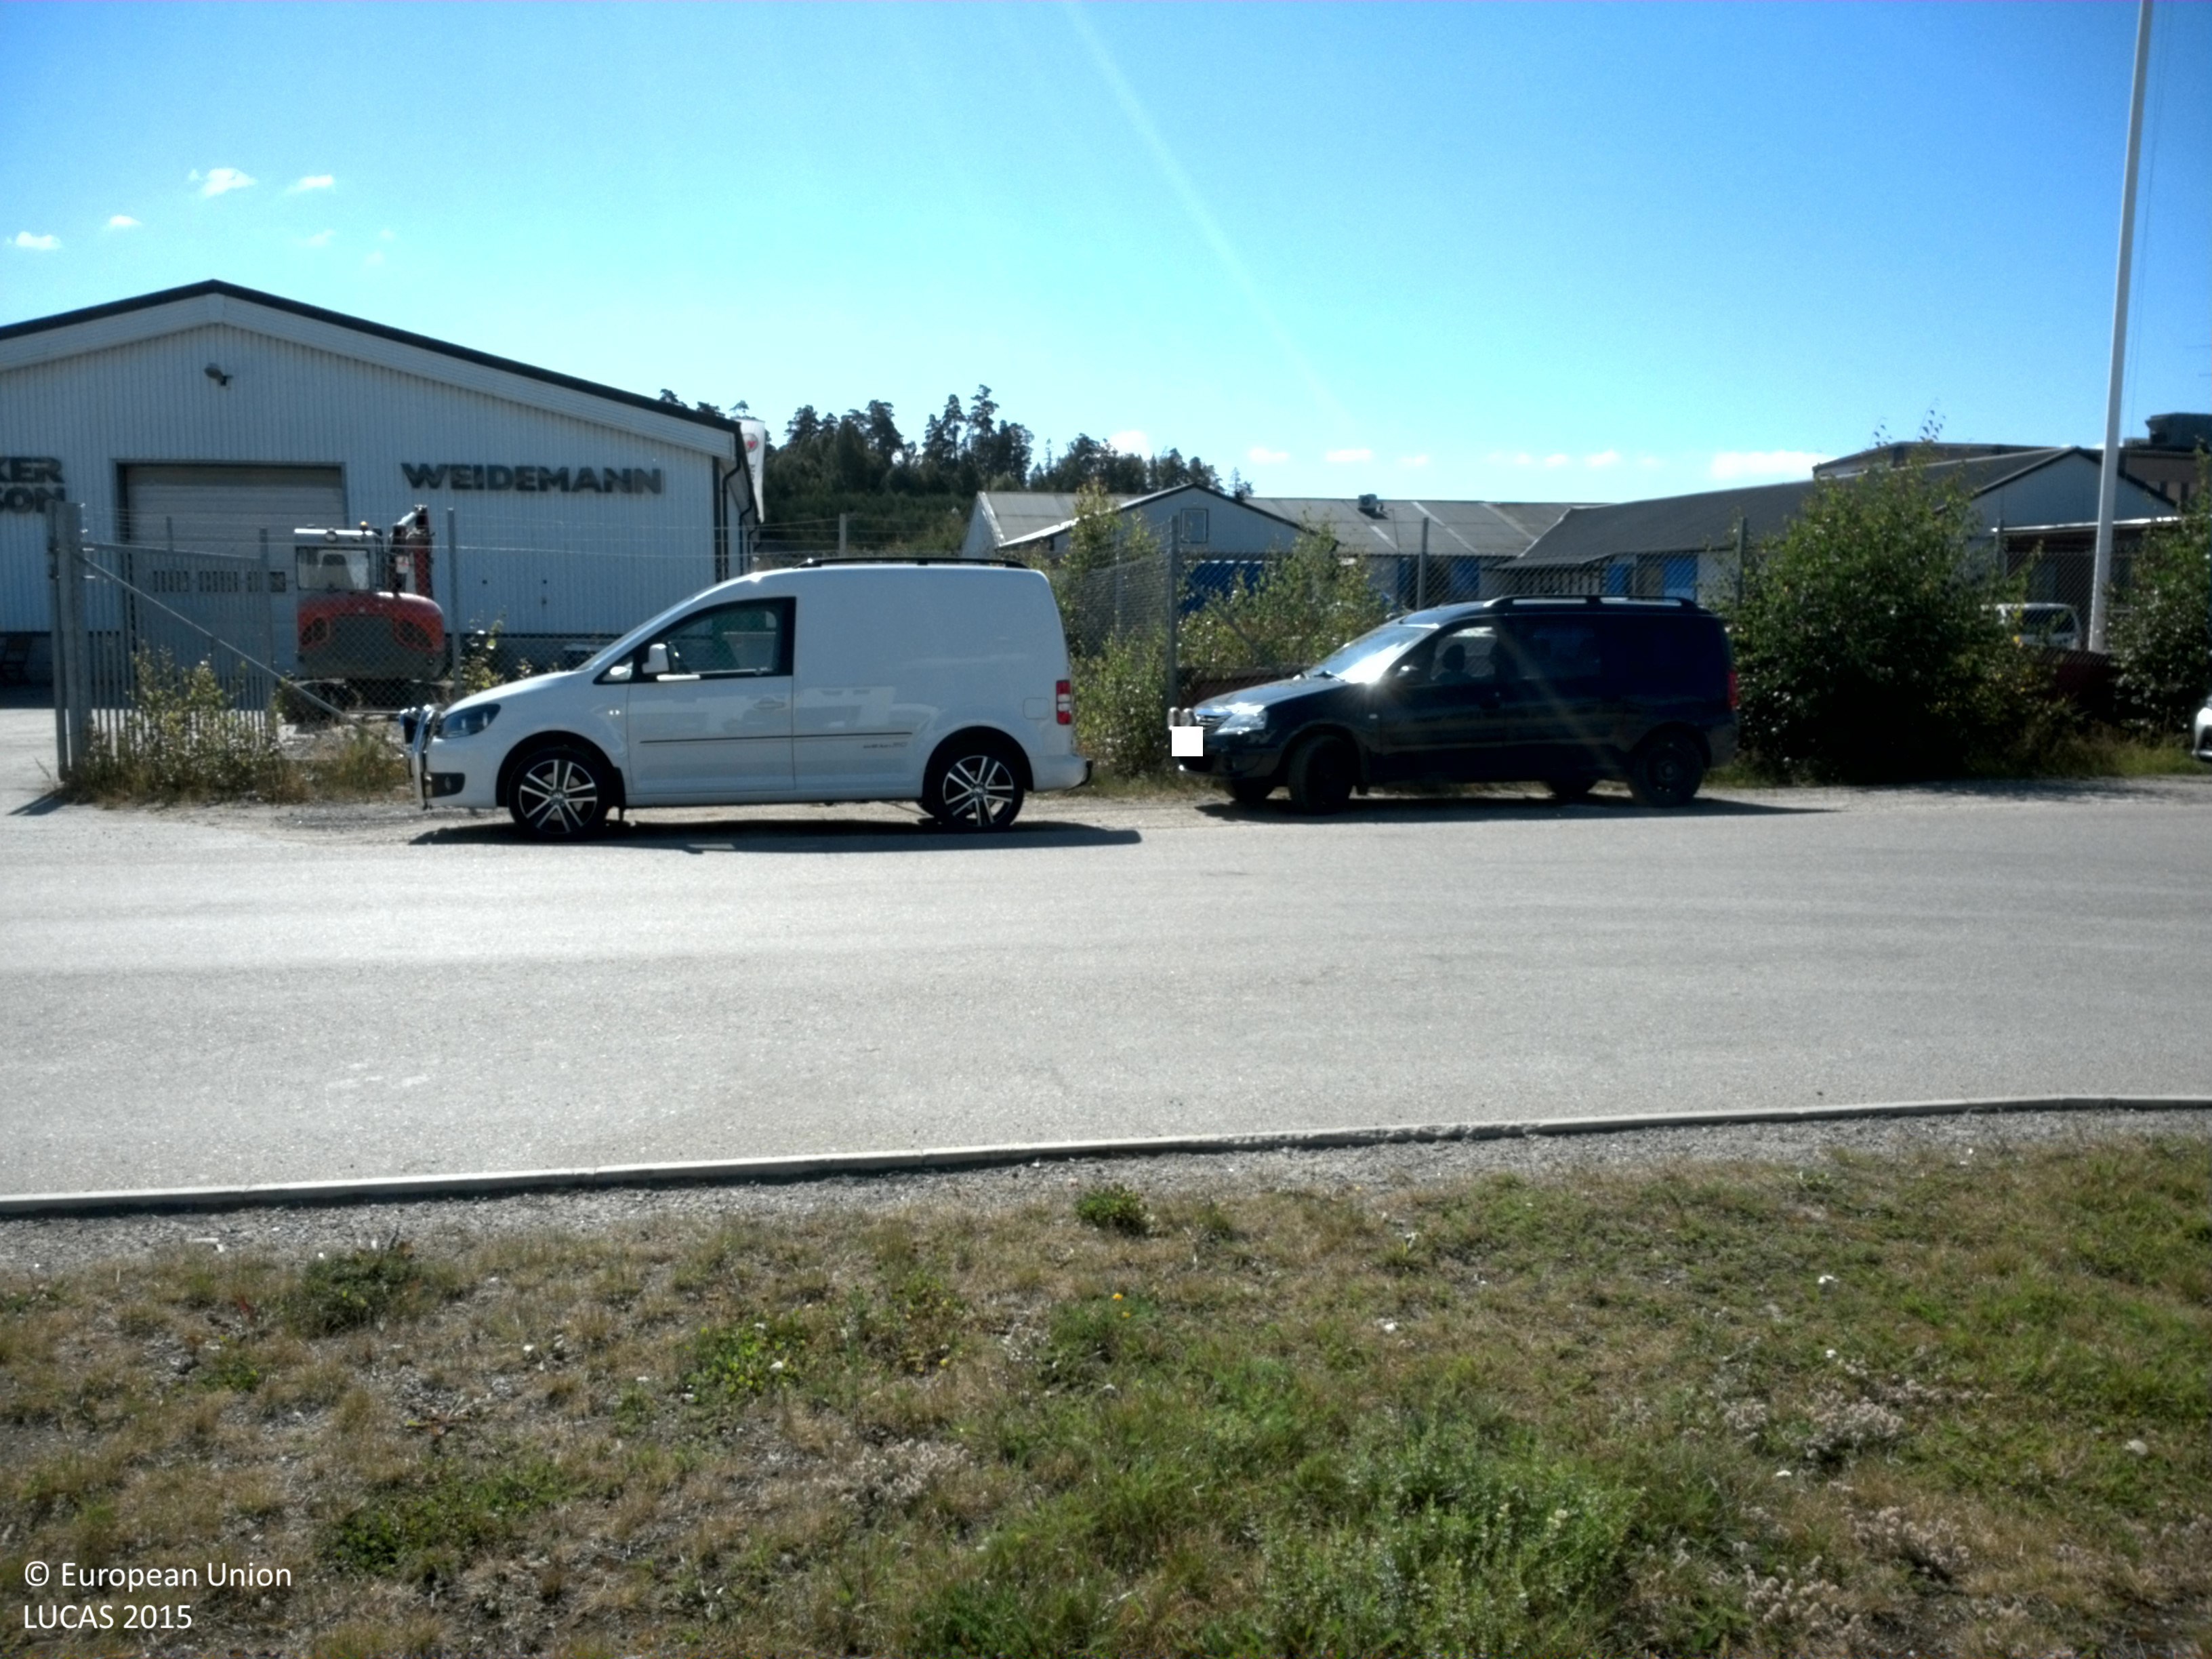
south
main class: Grassland
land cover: Grassland without tree/shrub cover
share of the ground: > 75 %
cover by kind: herbaceous plants 90 %, unconsolidated bare surface 10 %
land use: Commerce
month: August
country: SE
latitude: 59.5621
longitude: 17.5519
